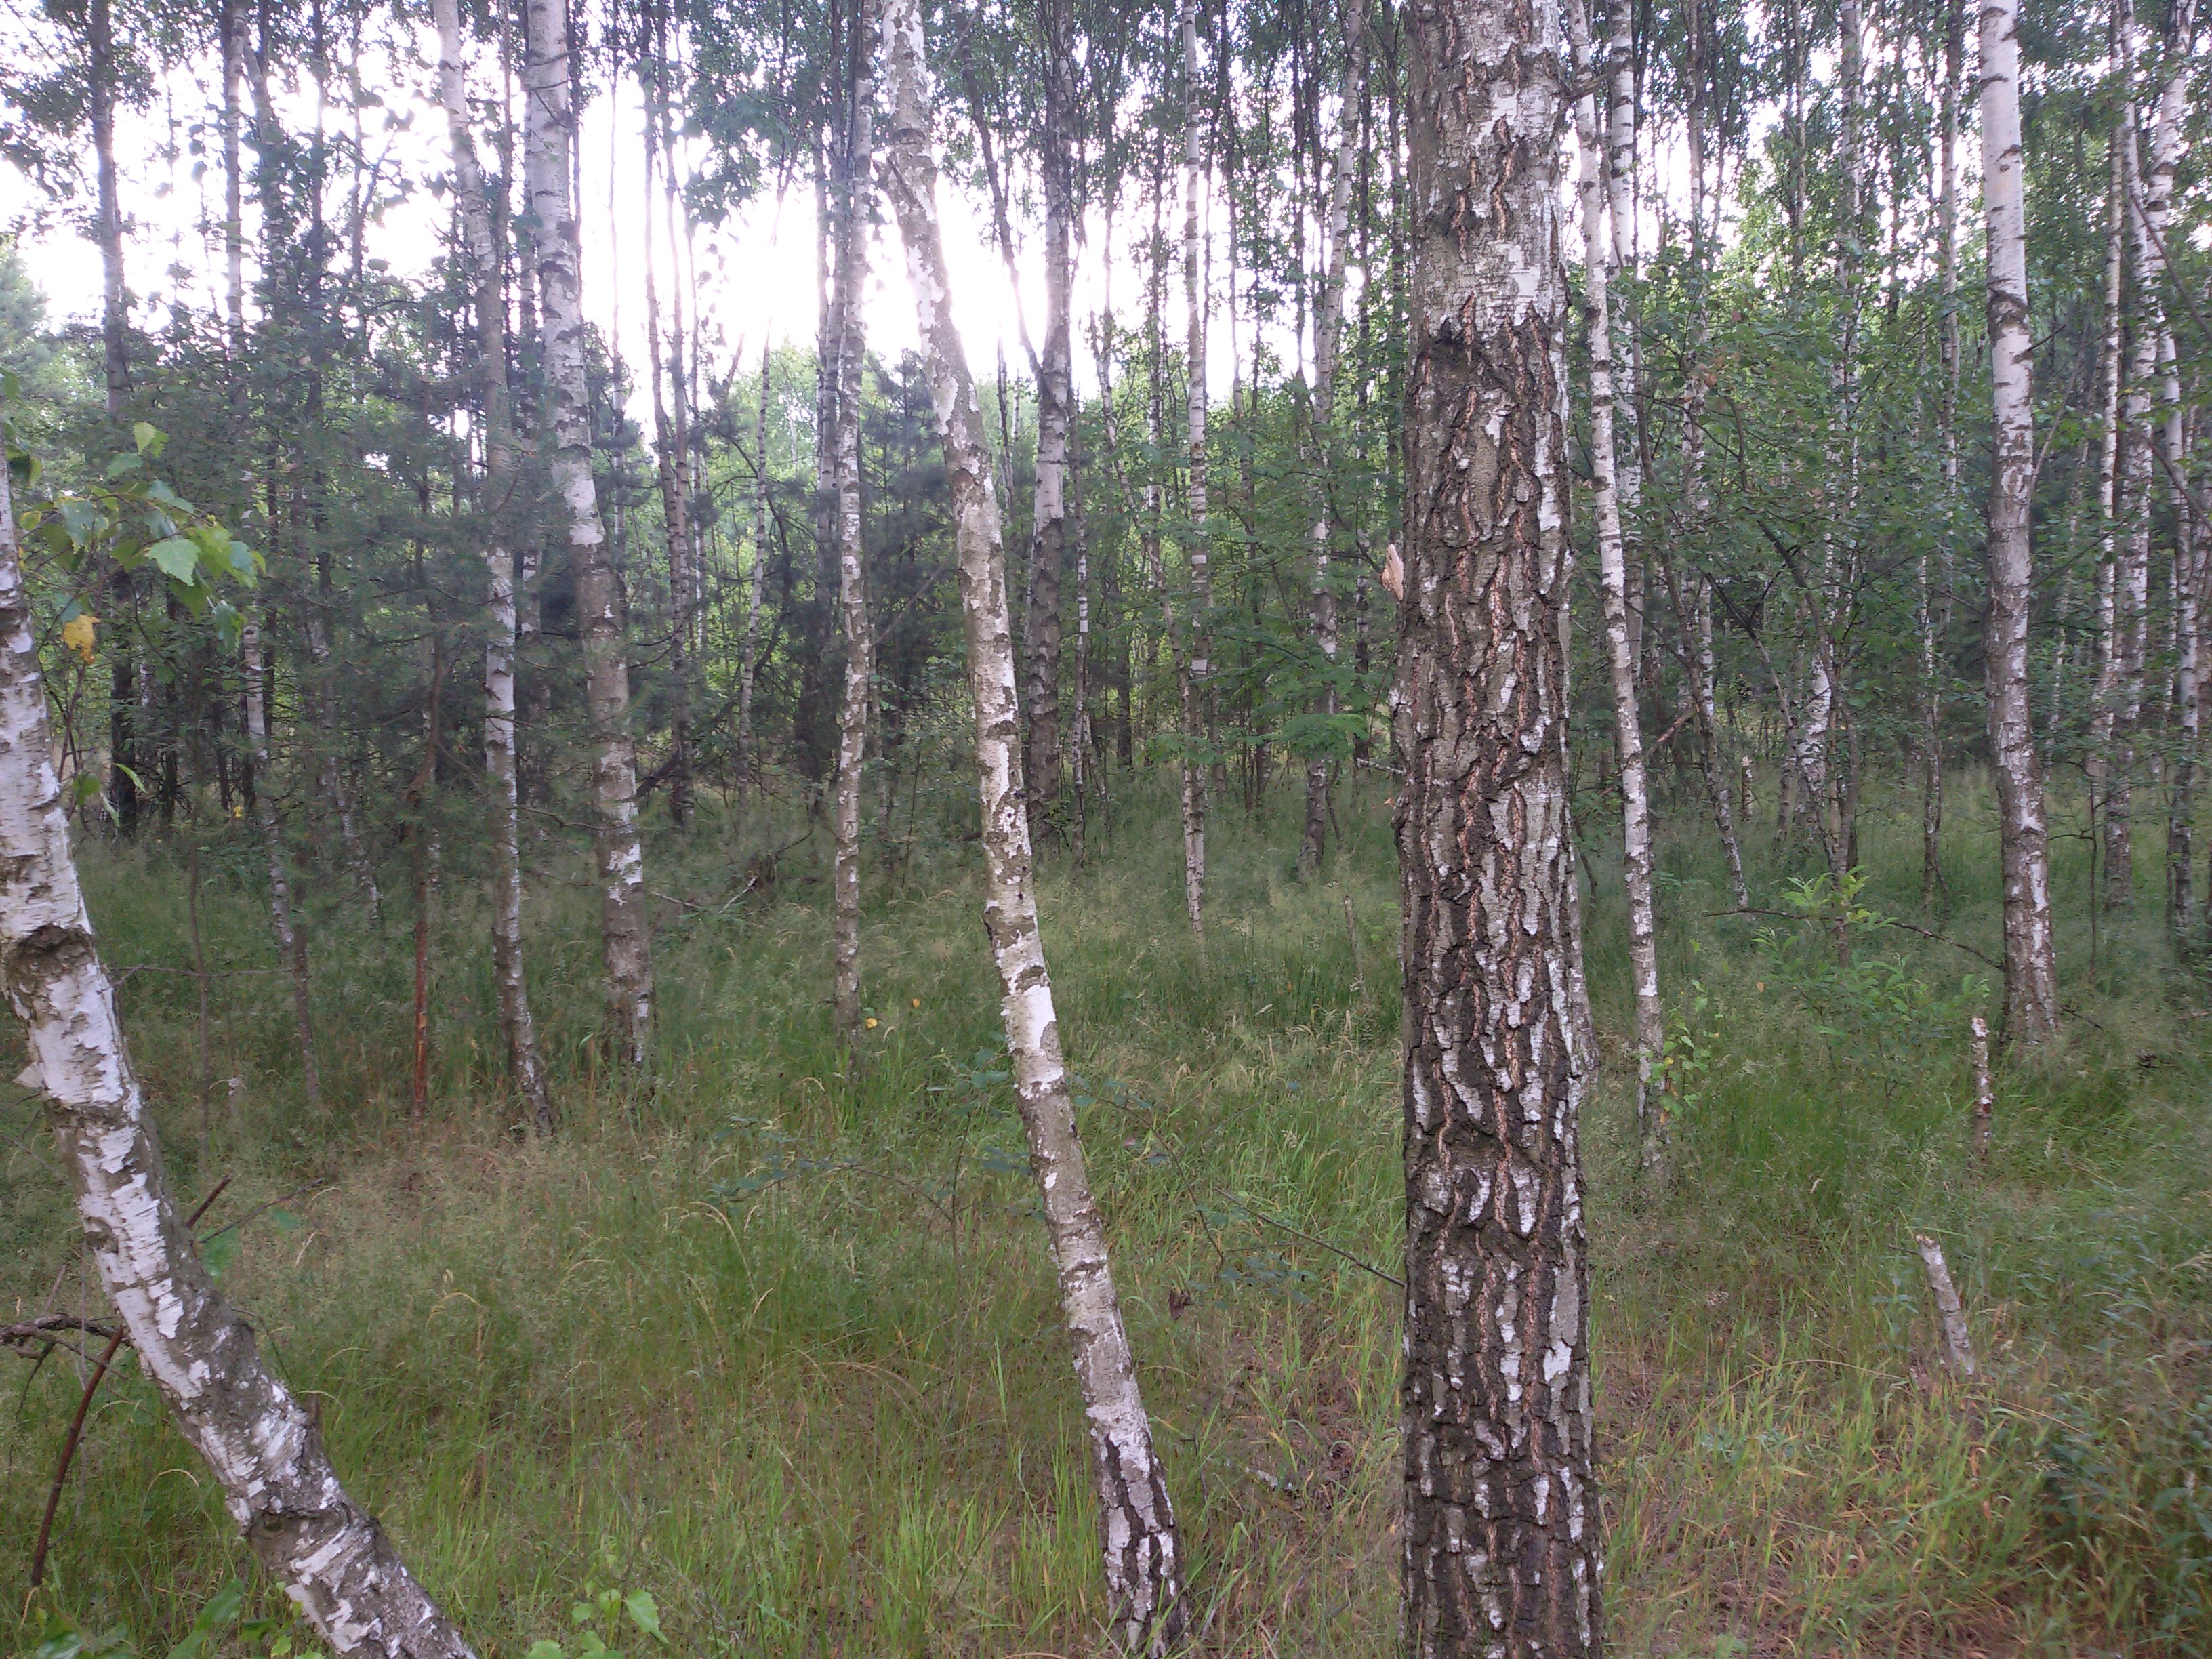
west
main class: Woodland
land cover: Broadleaved woodland
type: mesophytic deciduous forest
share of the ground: > 75 %
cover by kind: broadleaved forest trees 85 %, herbaceous plants 10 %, shrubs 5 %
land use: Forestry
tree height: > 5 m
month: June
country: PL
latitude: 51.8513
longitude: 23.0697
